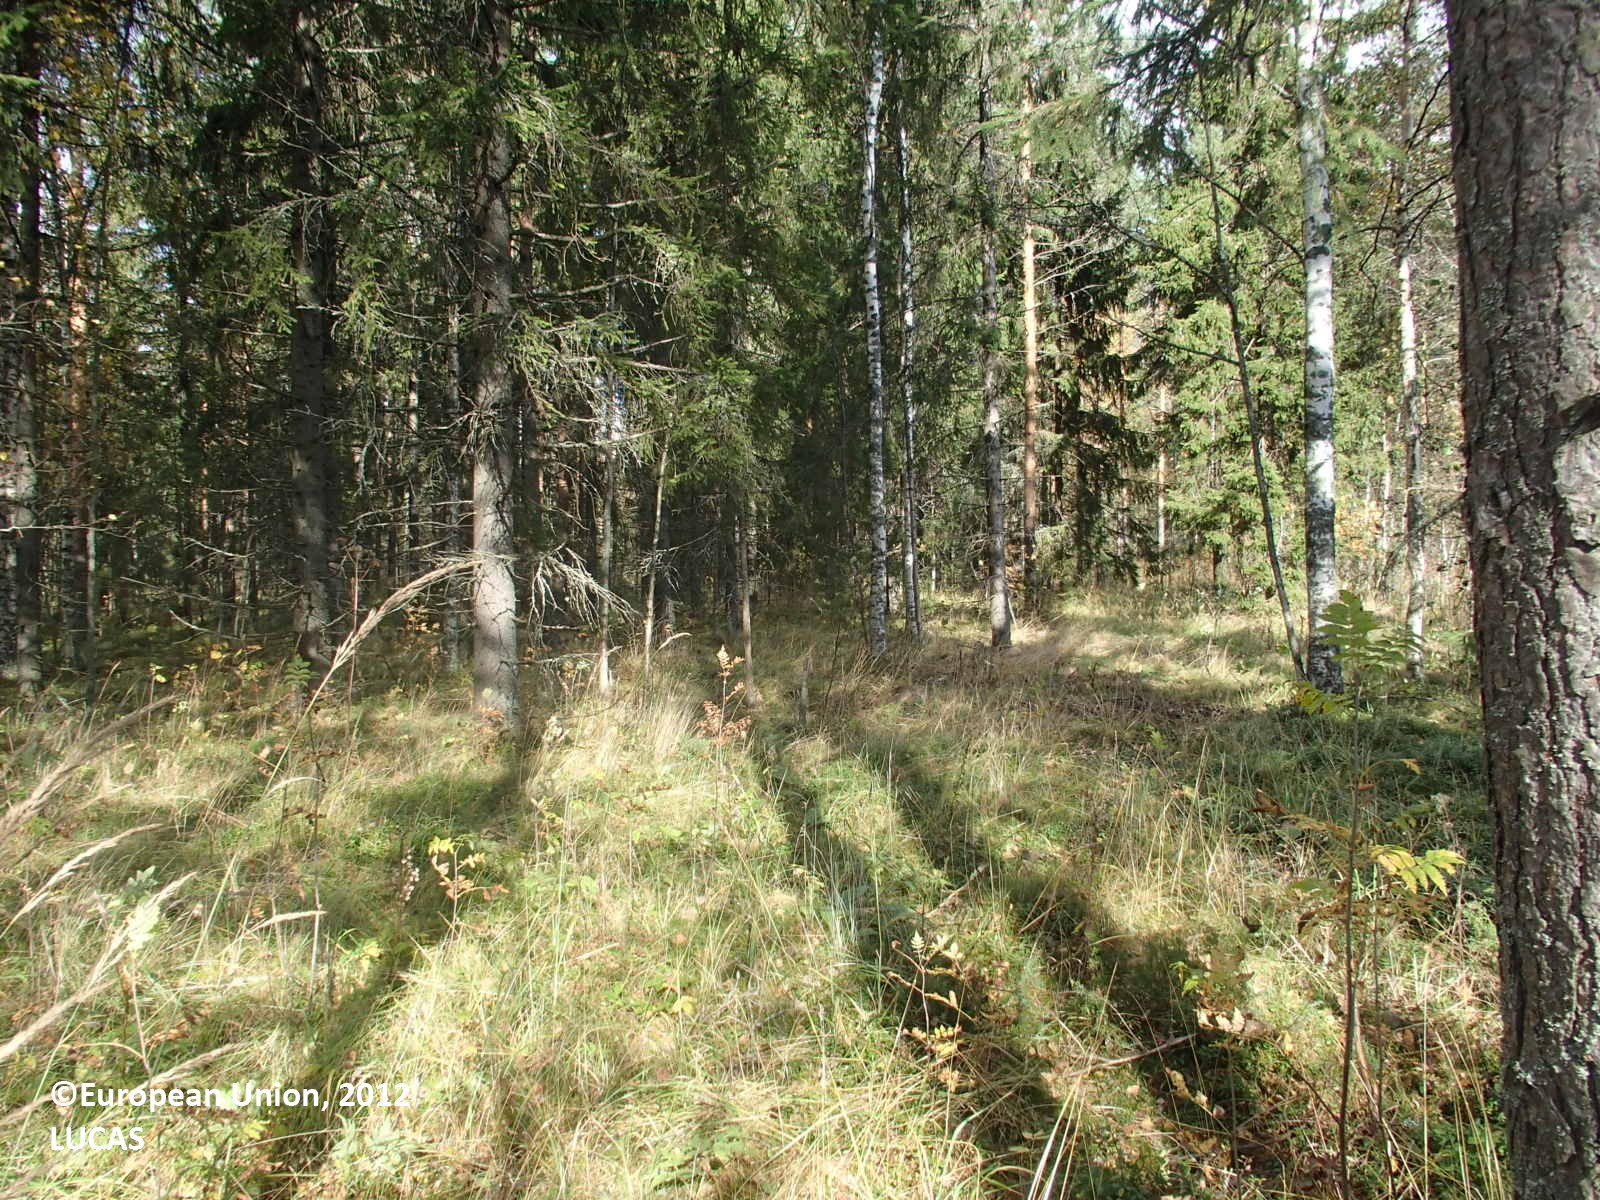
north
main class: Woodland
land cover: Spruce dominated mixed woodland
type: boreal forest
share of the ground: > 75 %
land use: Forestry
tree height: > 5 m
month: September
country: FI
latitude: 63.6200
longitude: 26.6506
